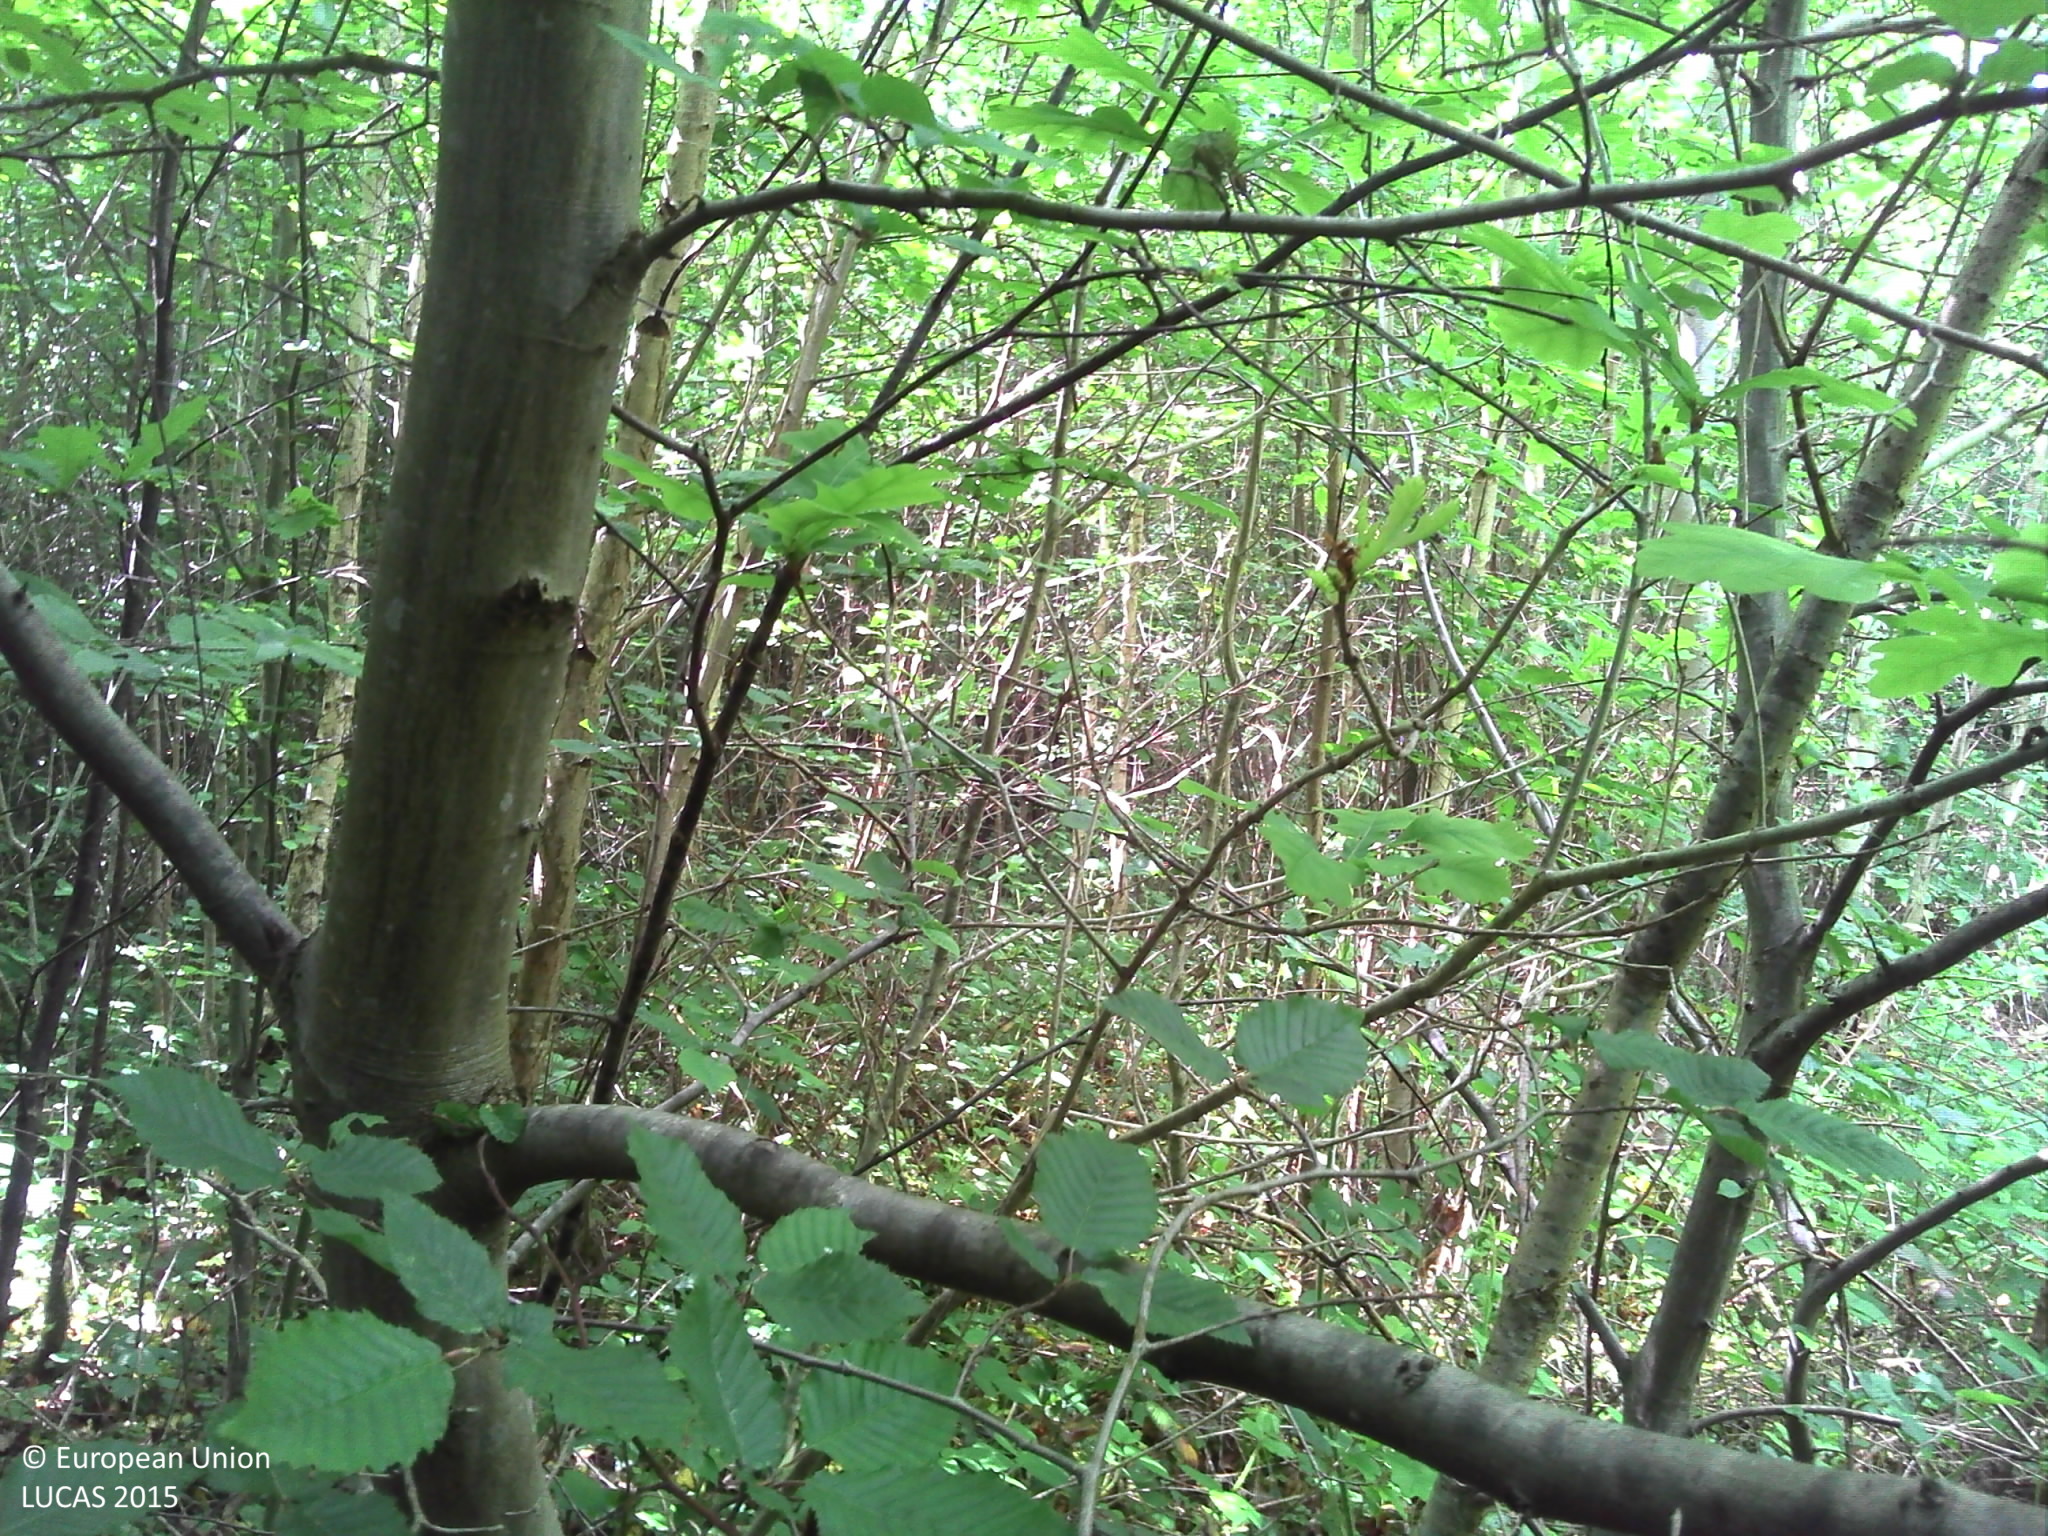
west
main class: Woodland
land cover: Broadleaved woodland
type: mesophytic deciduous forest
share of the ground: > 75 %
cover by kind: broadleaved forest trees 90 %, herbaceous plants 5 %, lichens and mosses 5 %
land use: Forestry
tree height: > 5 m
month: May
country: FR
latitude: 47.7888
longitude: 4.3250
